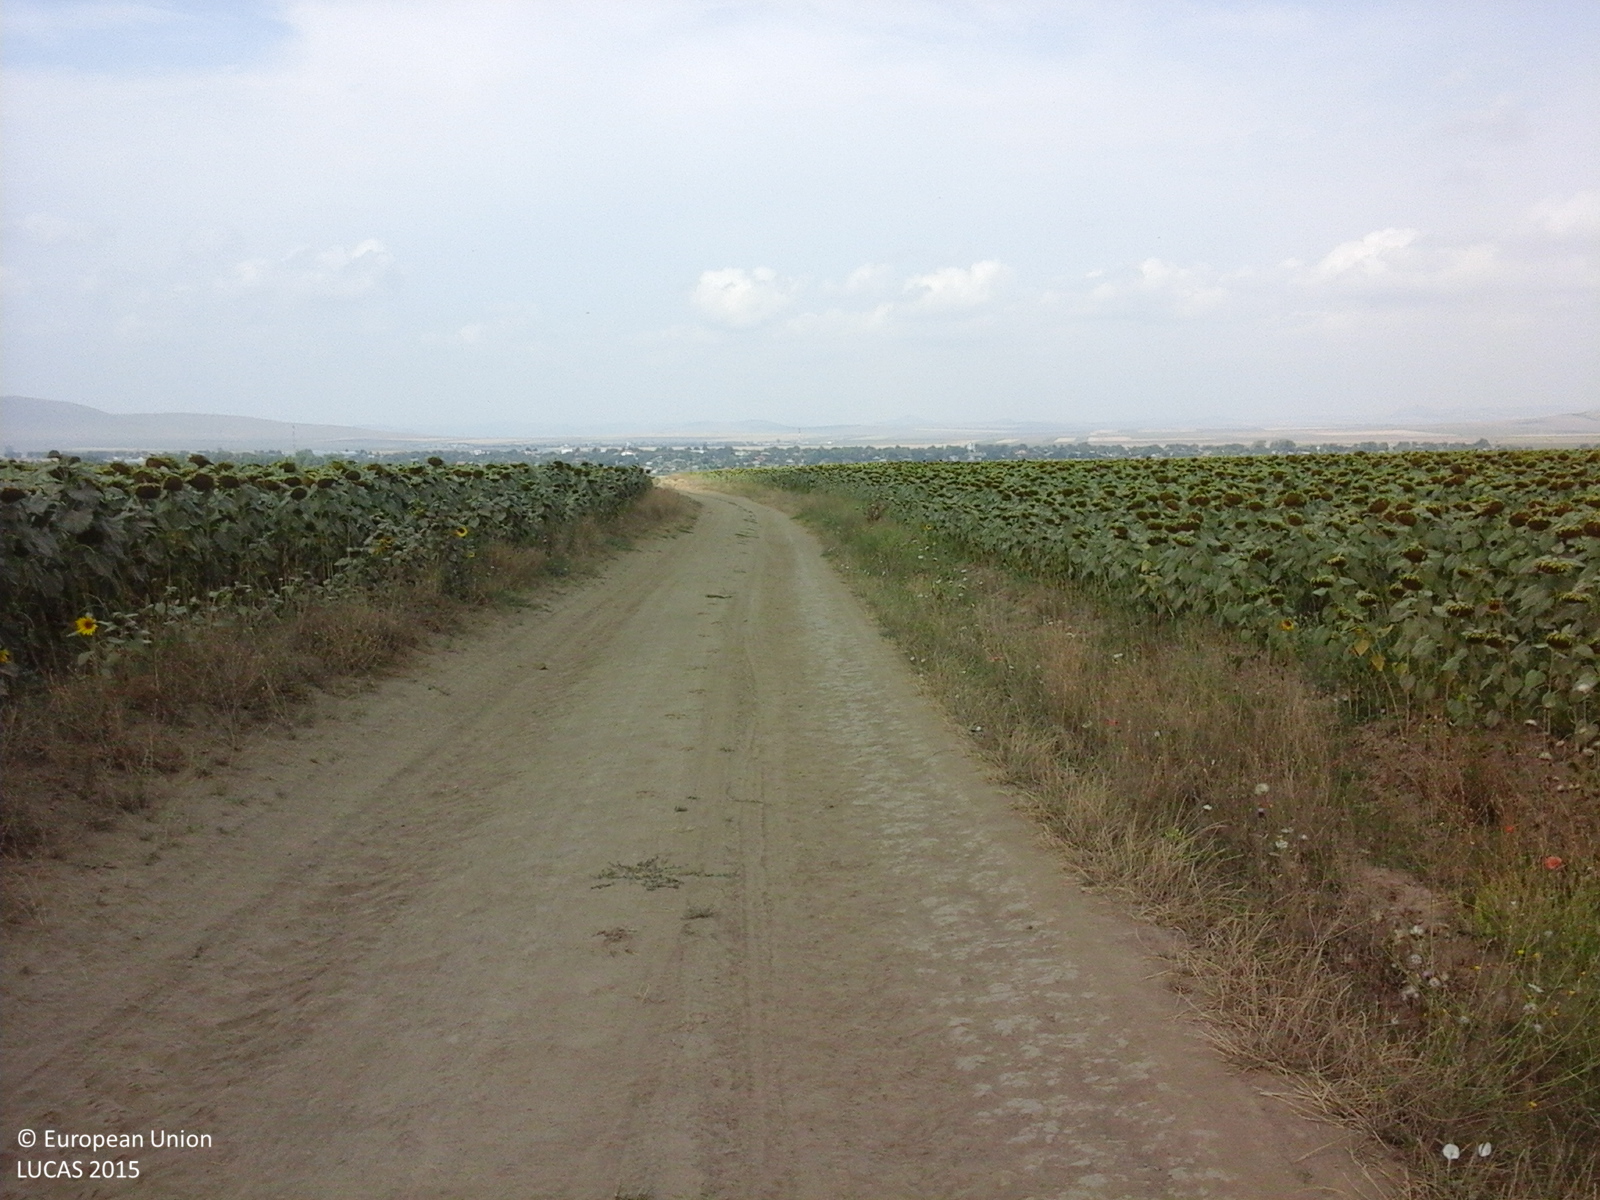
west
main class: Cropland
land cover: Sunflower
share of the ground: > 75 %
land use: Agriculture (excluding fallow land and kitchen gardens)
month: July
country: RO
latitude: 45.0410
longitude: 28.7615
